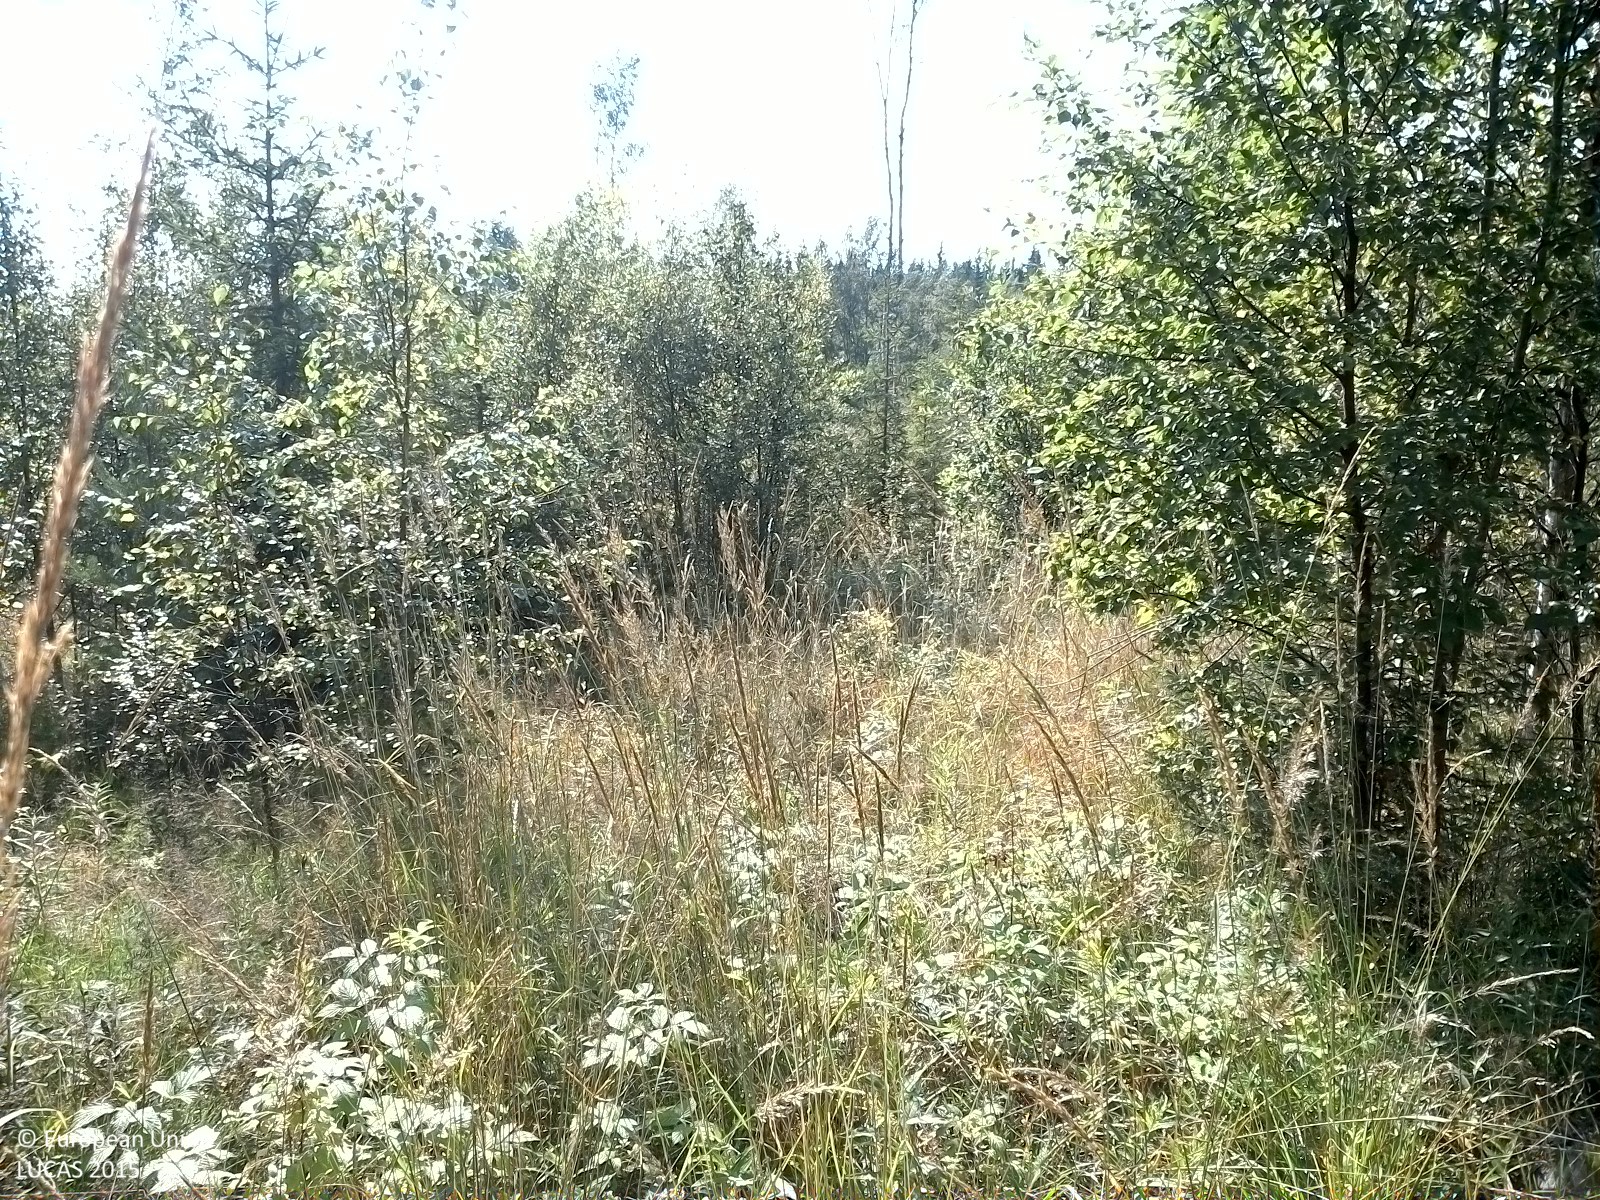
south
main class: Woodland
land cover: Other mixed woodland
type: boreal forest
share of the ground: 50 - 75 %
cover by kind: herbaceous plants 40 %, coniferous forest trees 35 %, broadleaved forest trees 20 %, shrubs 5 %
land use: Forestry
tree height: < 5 m
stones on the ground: < 10 %
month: August
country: SE
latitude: 62.4453
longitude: 16.2770
